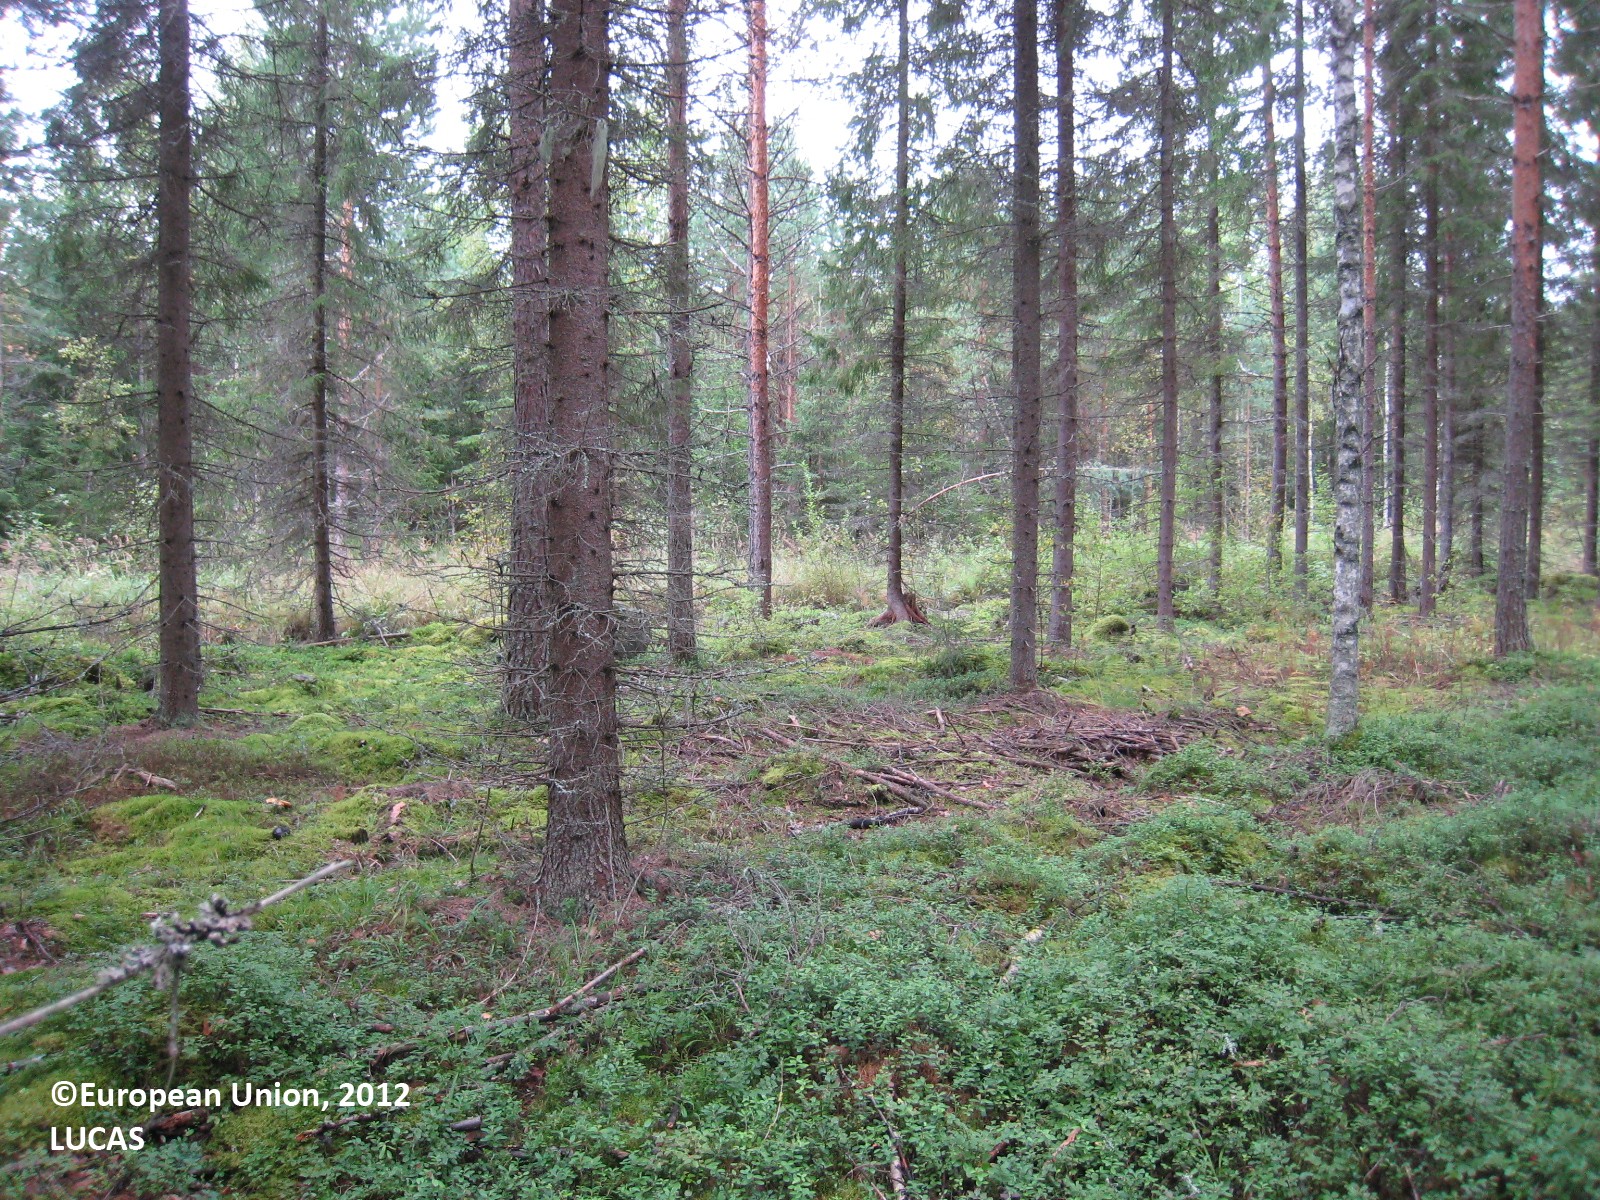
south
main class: Woodland
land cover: Other coniferous woodland
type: boreal forest
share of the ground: 50 - 75 %
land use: Forestry
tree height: > 5 m
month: August
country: FI
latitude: 62.1199
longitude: 27.1243
